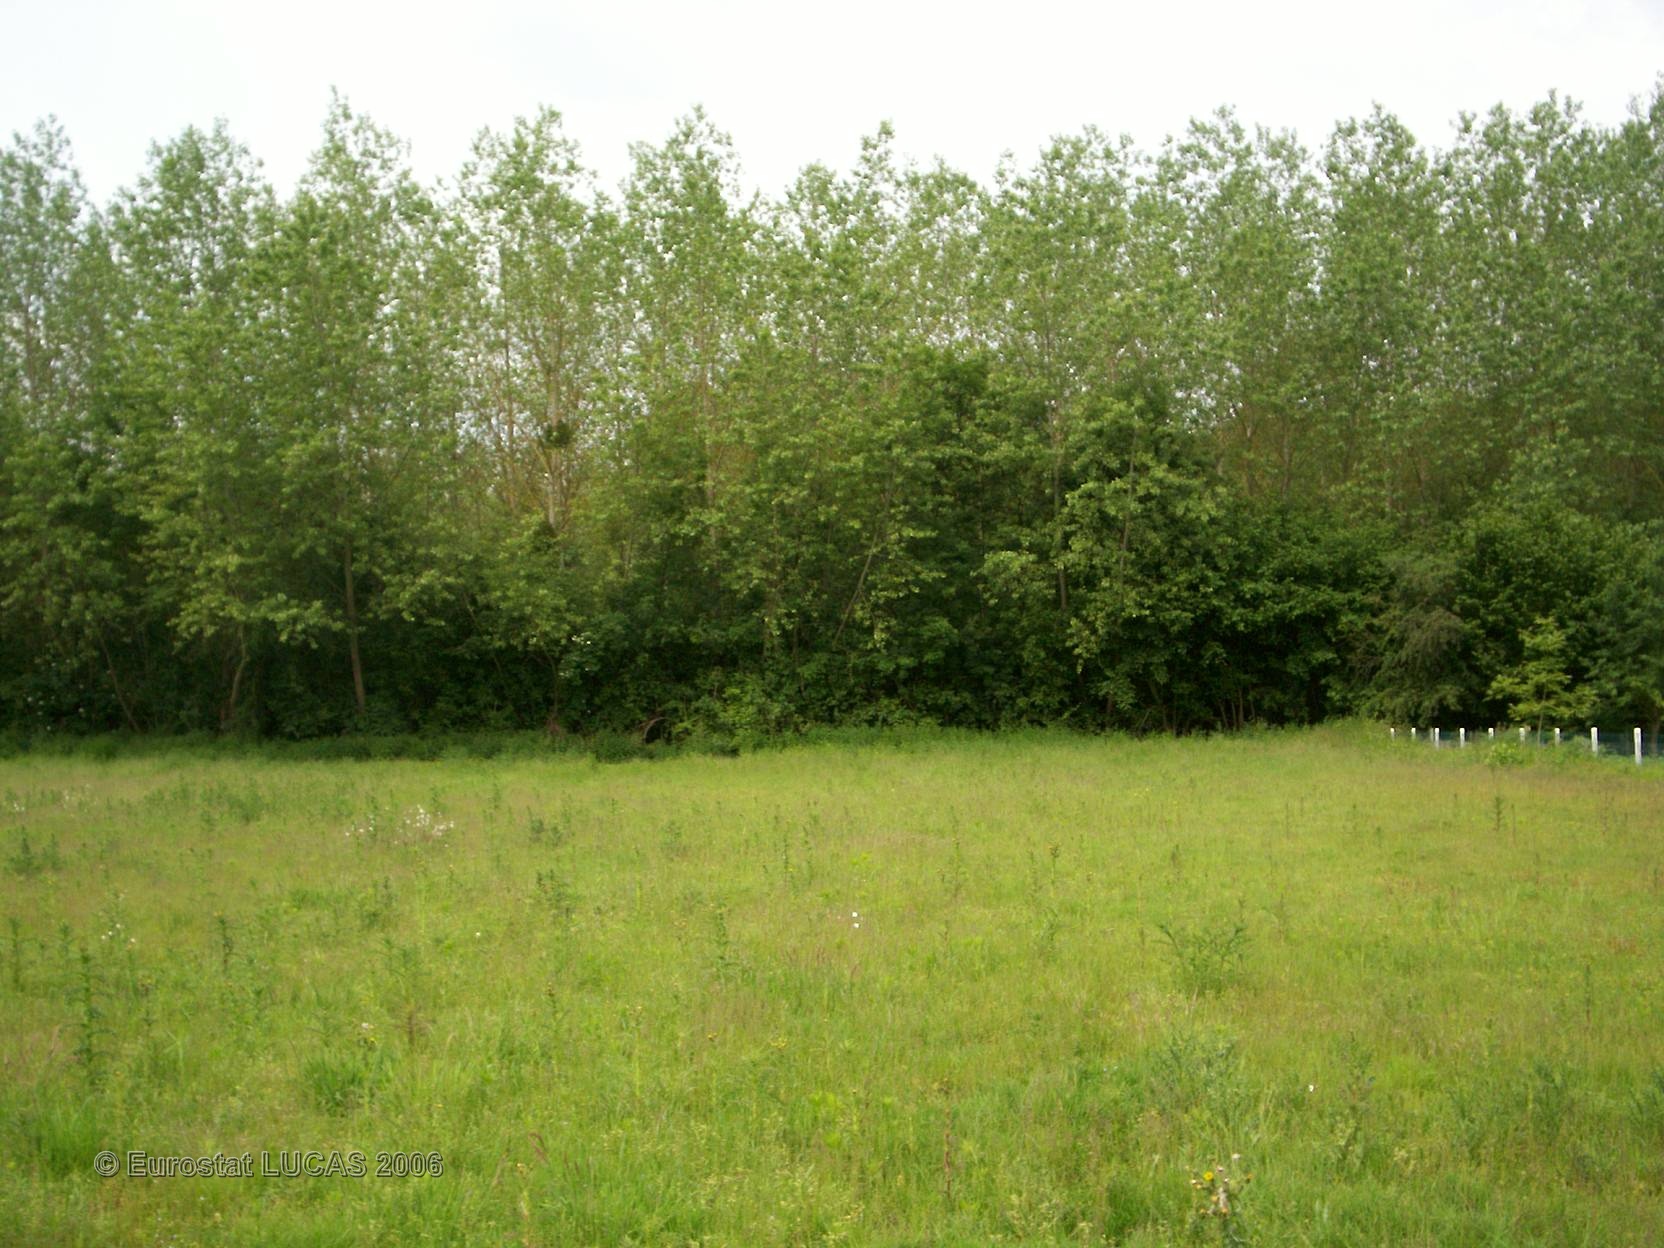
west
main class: Grassland
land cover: Grassland without tree/shrub cover
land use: Agriculture (excluding fallow land and kitchen gardens)
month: June
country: FR
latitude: 49.3349
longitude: 2.6817
